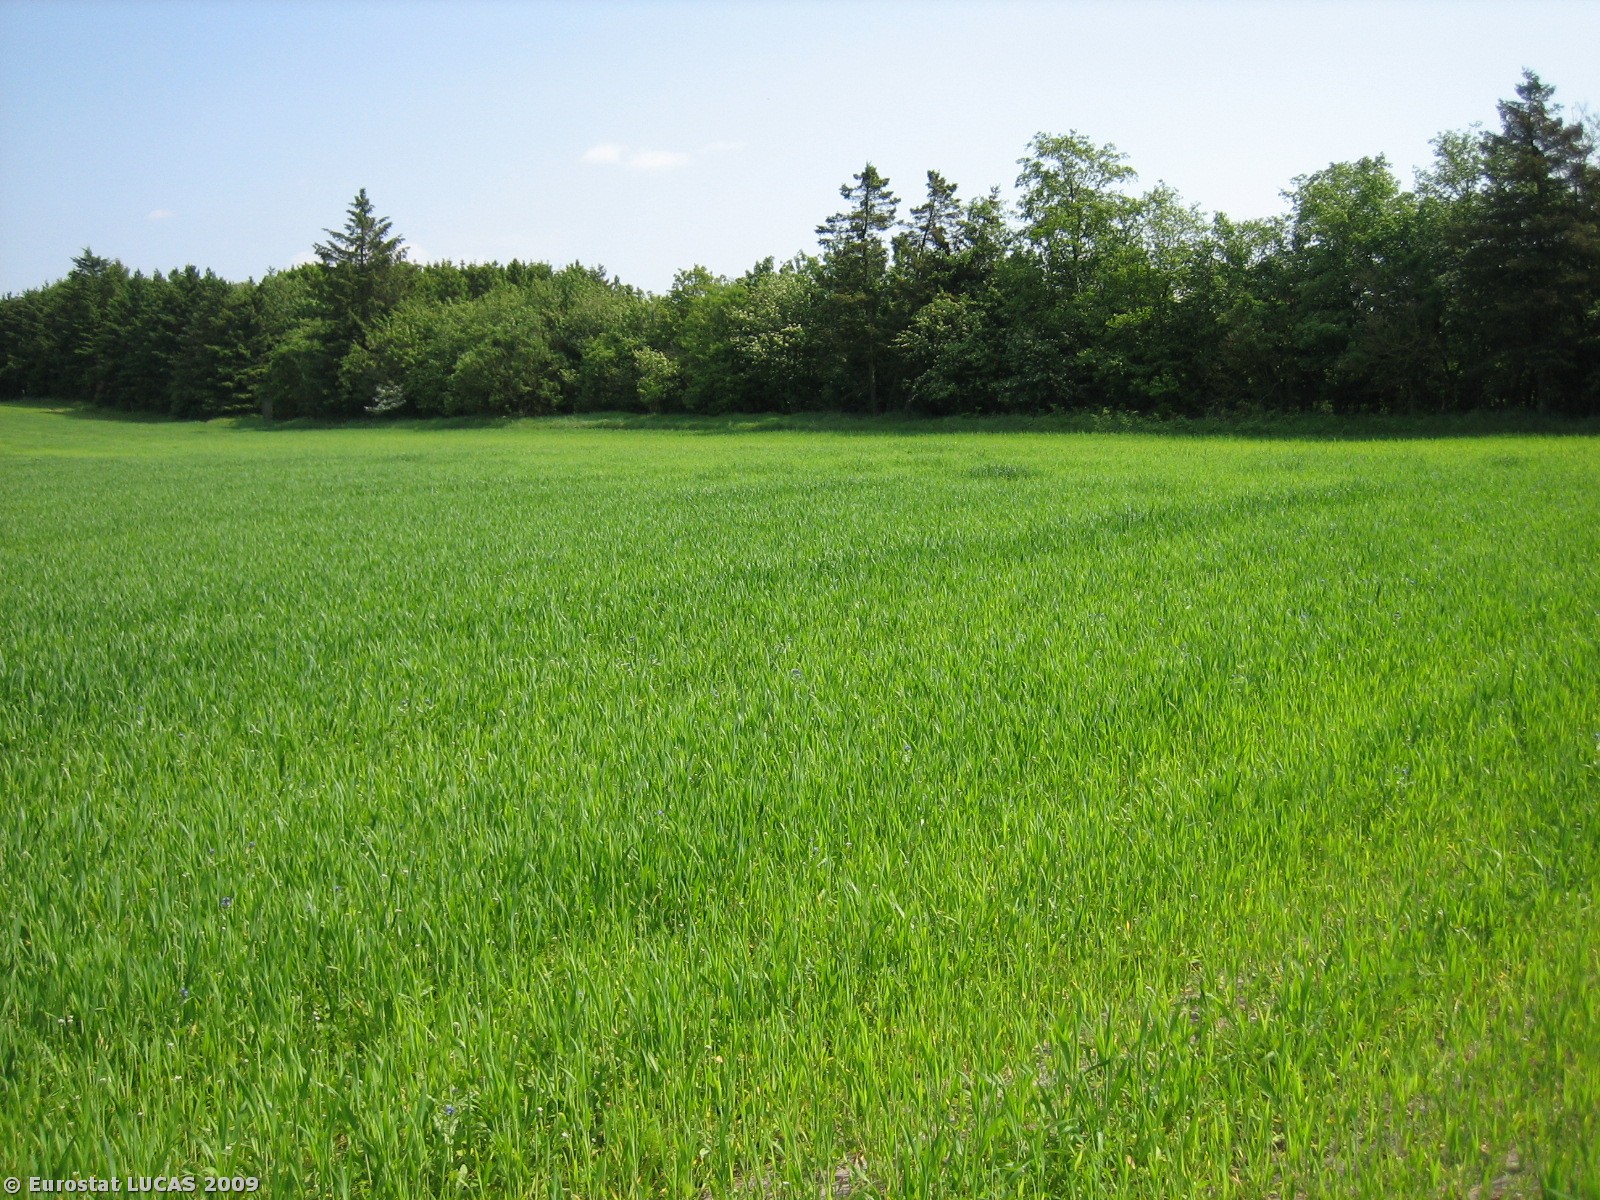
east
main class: Cropland
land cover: Barley
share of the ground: > 75 %
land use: Agriculture (excluding fallow land and kitchen gardens)
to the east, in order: Barley; Broadleaved woodland; Shrubland with sparse tree cover; Grassland without tree/shrub cover; Artificial constructions in urban areas; Coniferous woodland
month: May
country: DK
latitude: 56.1138
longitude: 9.2771
